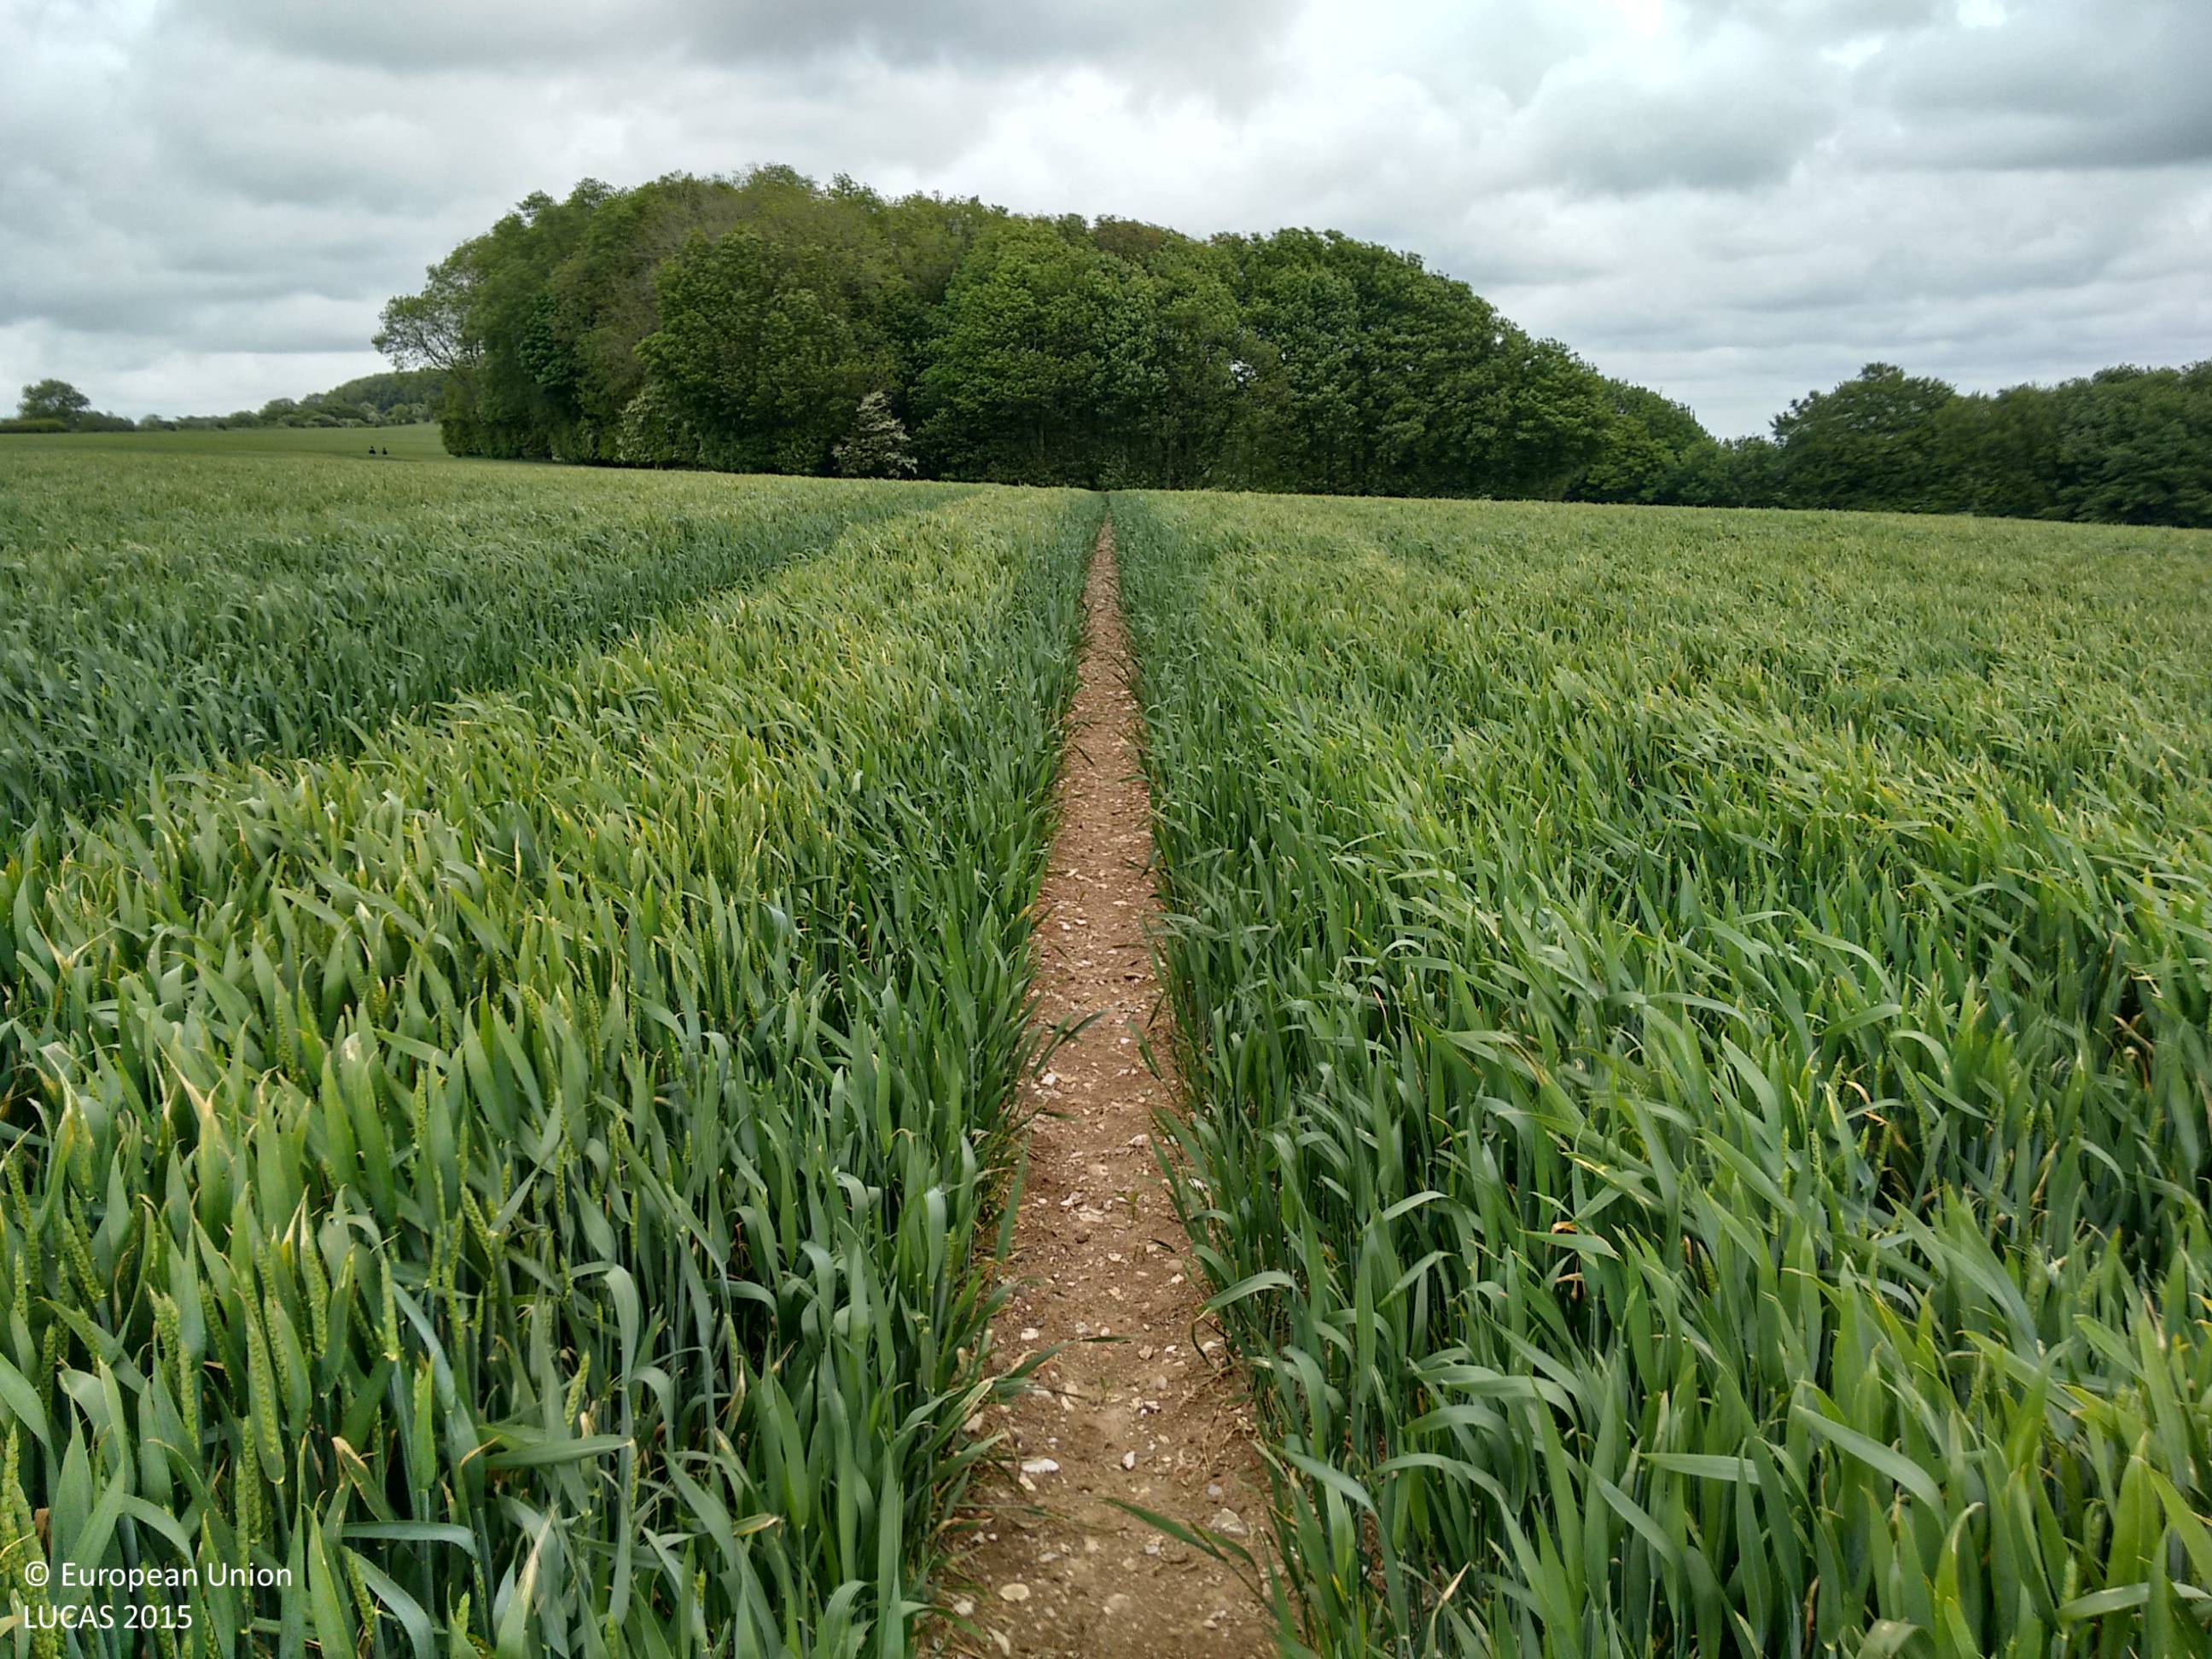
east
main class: Cropland
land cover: Common wheat
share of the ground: > 75 %
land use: Agriculture (excluding fallow land and kitchen gardens)
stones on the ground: > 50 %
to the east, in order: Common wheat; Broadleaved woodland; Other bare soil; Tracks; Grassland without tree/shrub cover; Other bare soil; Broadleaved woodland; Other bare soil; Barley
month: June
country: GB
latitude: 50.8145
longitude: -2.3982
